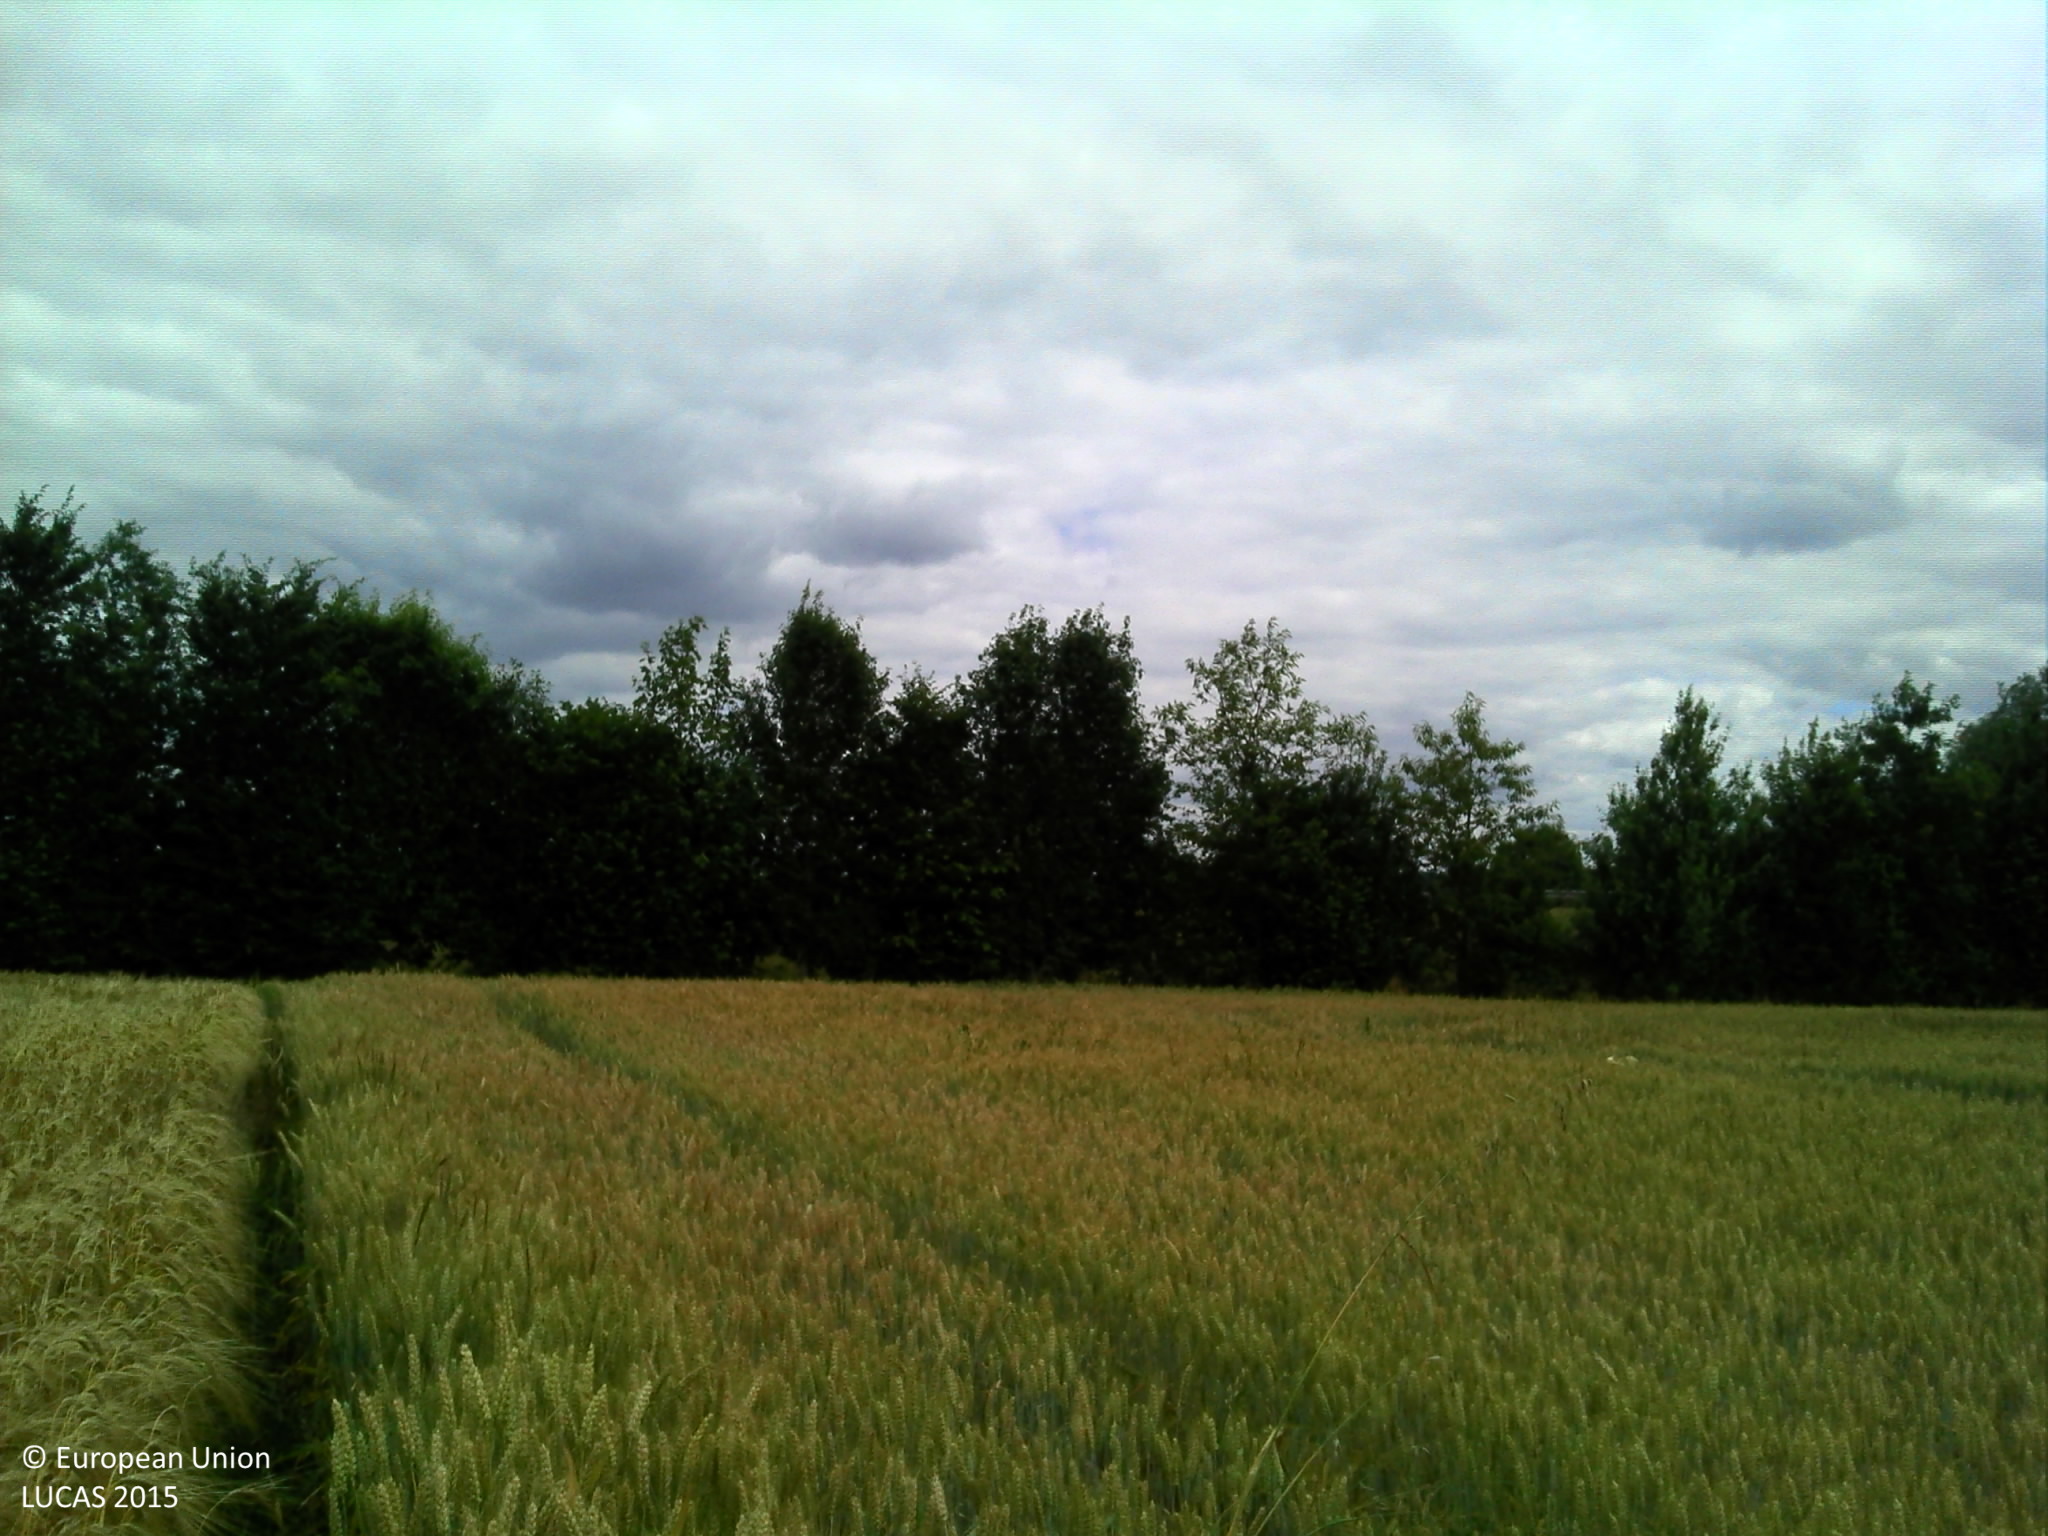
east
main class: Cropland
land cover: Common wheat
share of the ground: > 75 %
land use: Agriculture (excluding fallow land and kitchen gardens)
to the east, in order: Common wheat; Lines of trees; Fences; Grassland without tree/shrub cover; Ditches and canals; Paved roads, cycling and walking lanes; Ditches and canals; Grassland without tree/shrub cover; Fences; Maize
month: June
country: FR
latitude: 47.9039
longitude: 0.3031
